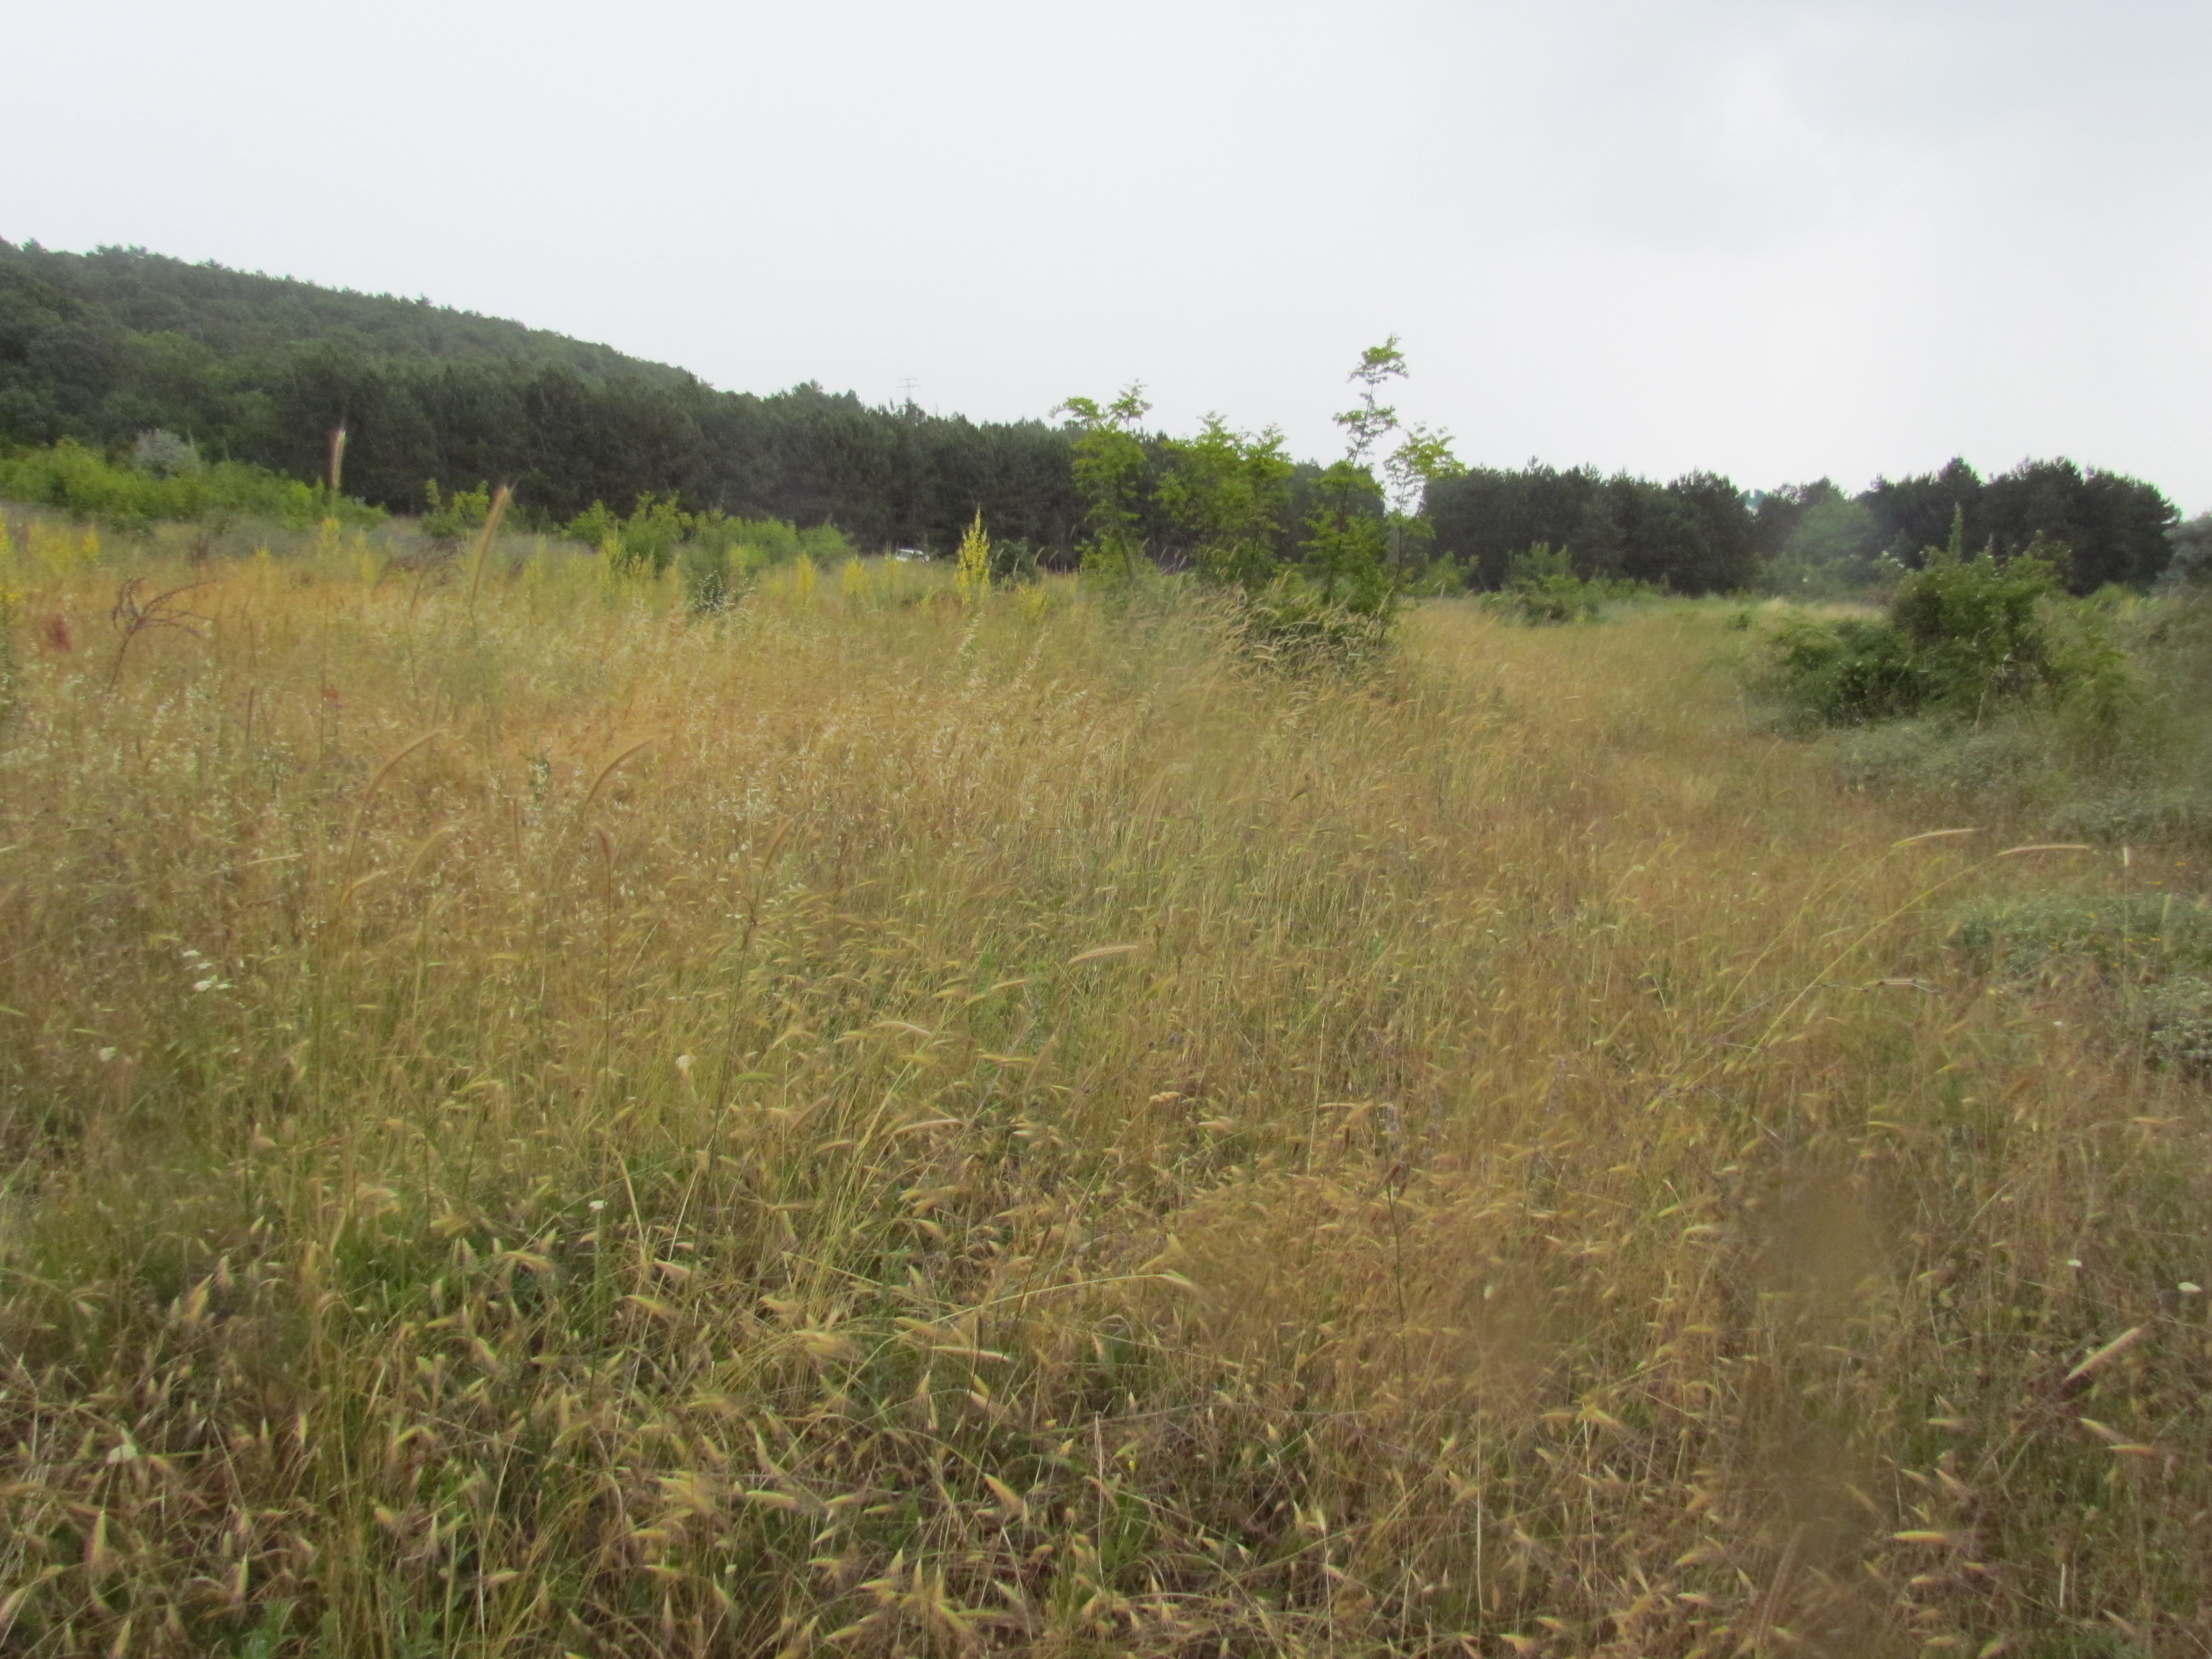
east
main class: Grassland
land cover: Grassland with sparse tree/shrub cover
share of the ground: > 75 %
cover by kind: herbaceous plants 90 %, broadleaved forest trees 5 %, shrubs 5 %
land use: Semi-natural and natural areas not in use
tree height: > 5 m
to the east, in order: Grassland with sparse tree/shrub cover; Tracks; Grassland with sparse tree/shrub cover; Pine dominated coniferous woodland
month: June
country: BG
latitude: 42.7050
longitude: 27.7946
